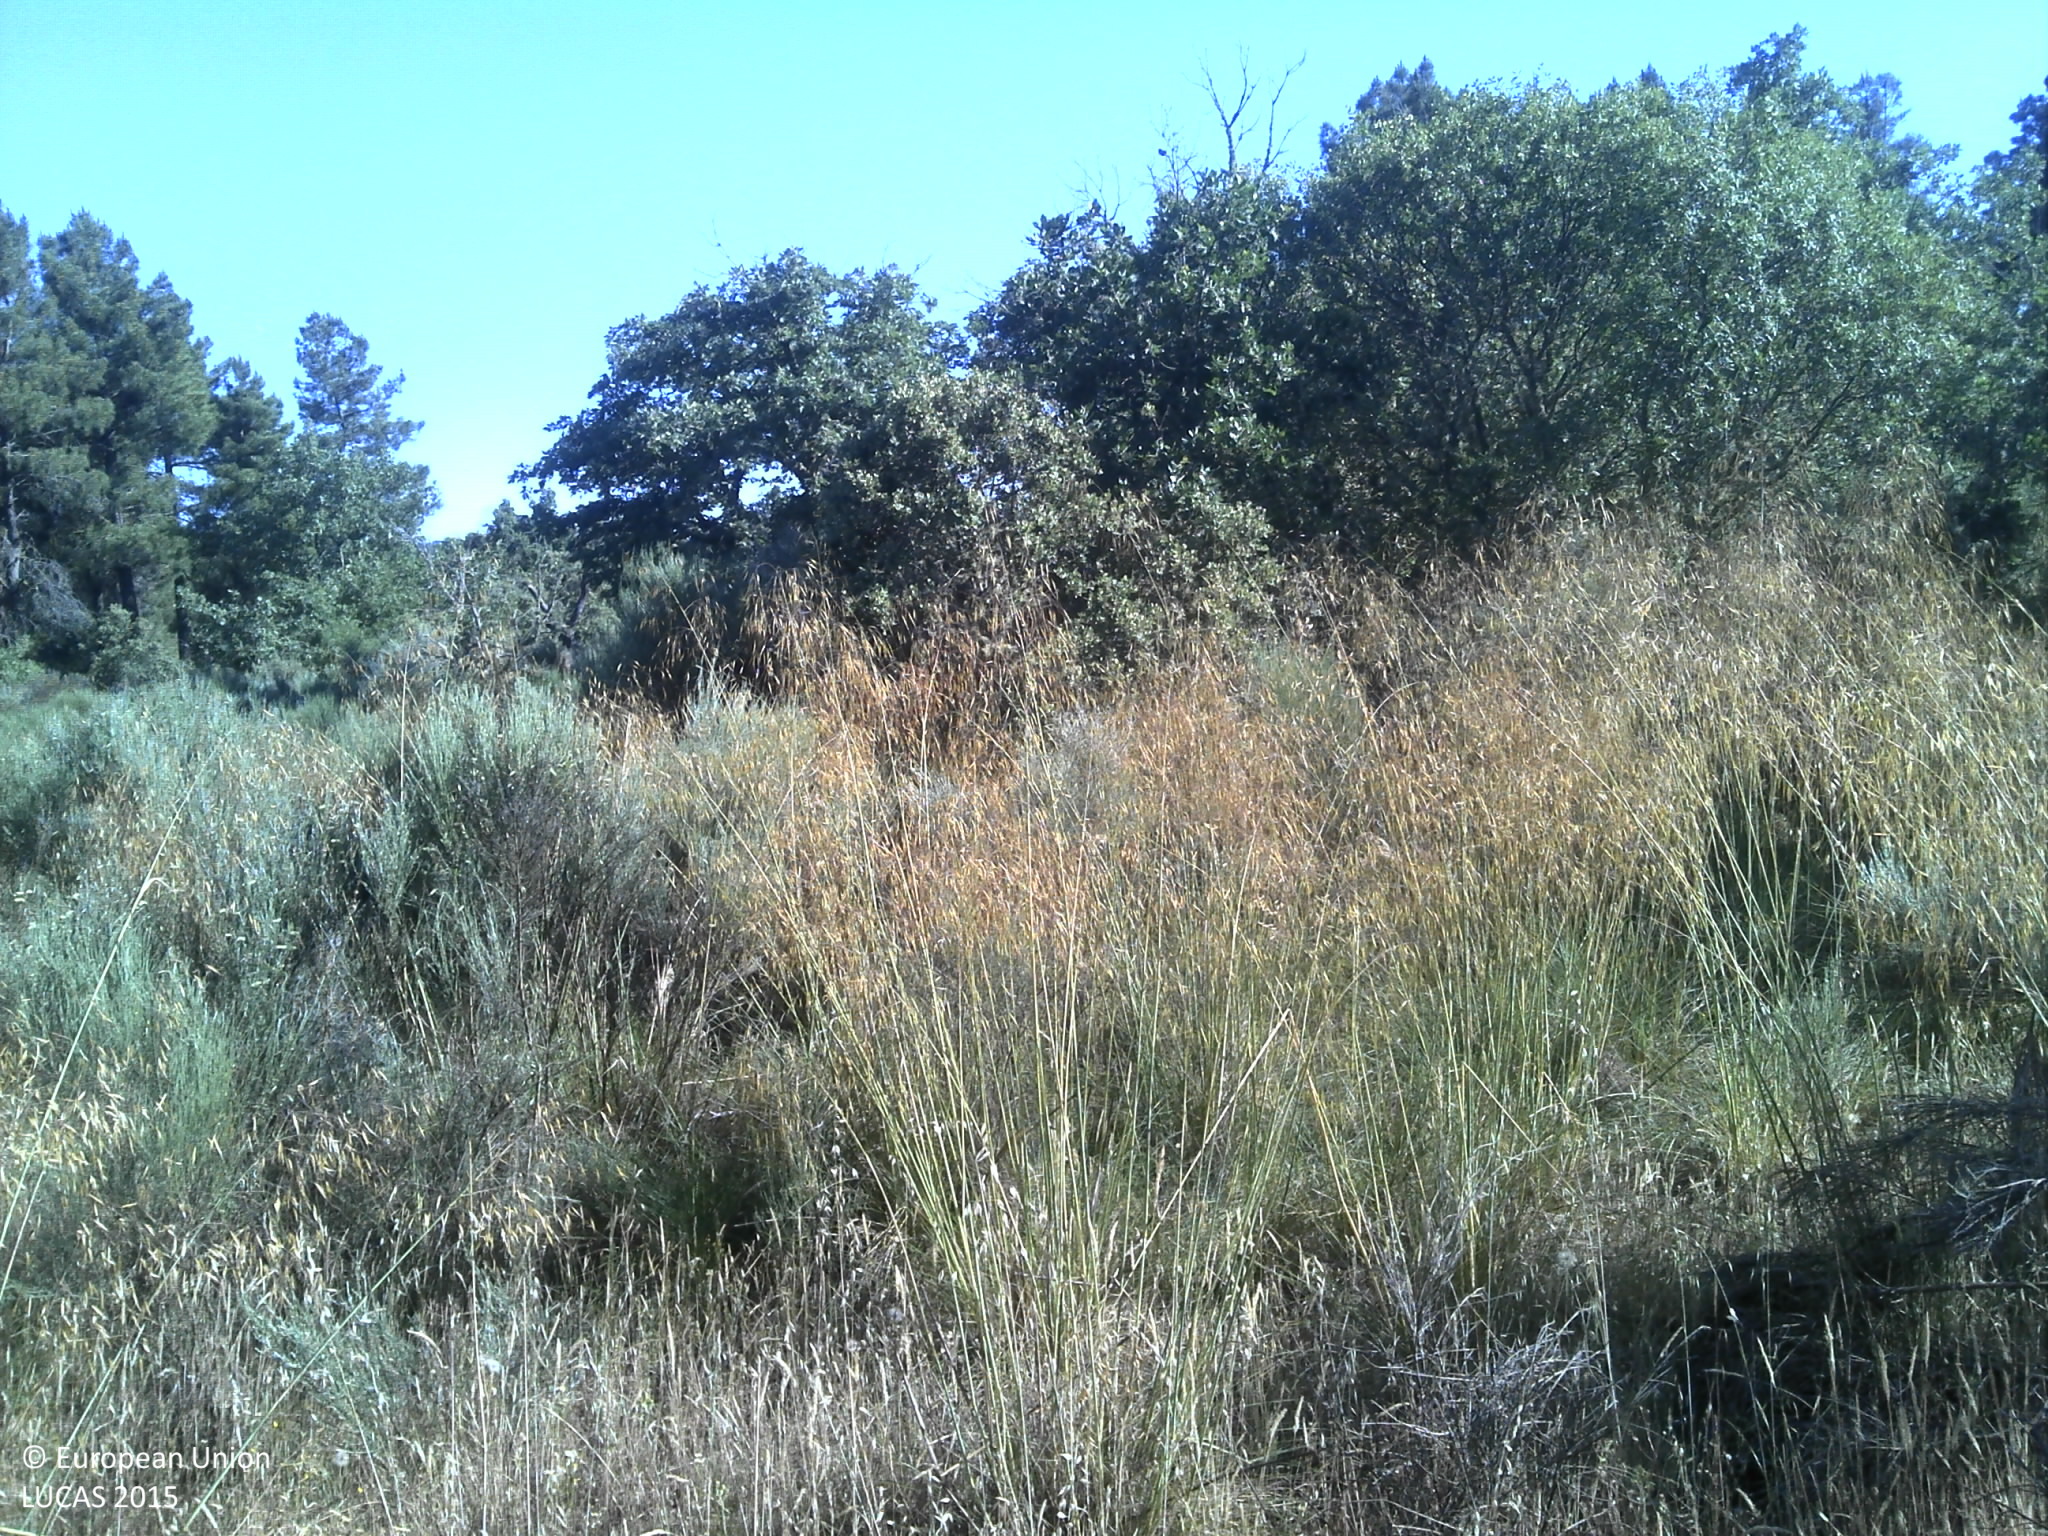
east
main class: Shrubland
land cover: Shrubland with sparse tree cover
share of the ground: 50 - 75 %
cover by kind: shrubs 65 %, herbaceous plants 15 %, unconsolidated bare surface 15 %, broadleaved forest trees 5 %
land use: Agriculture (excluding fallow land and kitchen gardens)
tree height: > 5 m
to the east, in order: Shrubland with sparse tree cover; Rocks and stones; Shrubland with sparse tree cover; Broadleaved woodland; Dry stone walls; Tracks; Shrubland with sparse tree cover; Tracks; Broadleaved woodland; Tracks; Broadleaved woodland; Fences; Lines of trees; Durum wheat; Single bushes/trees; Durum wheat
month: June
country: PT
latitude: 40.6661
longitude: -6.8115
